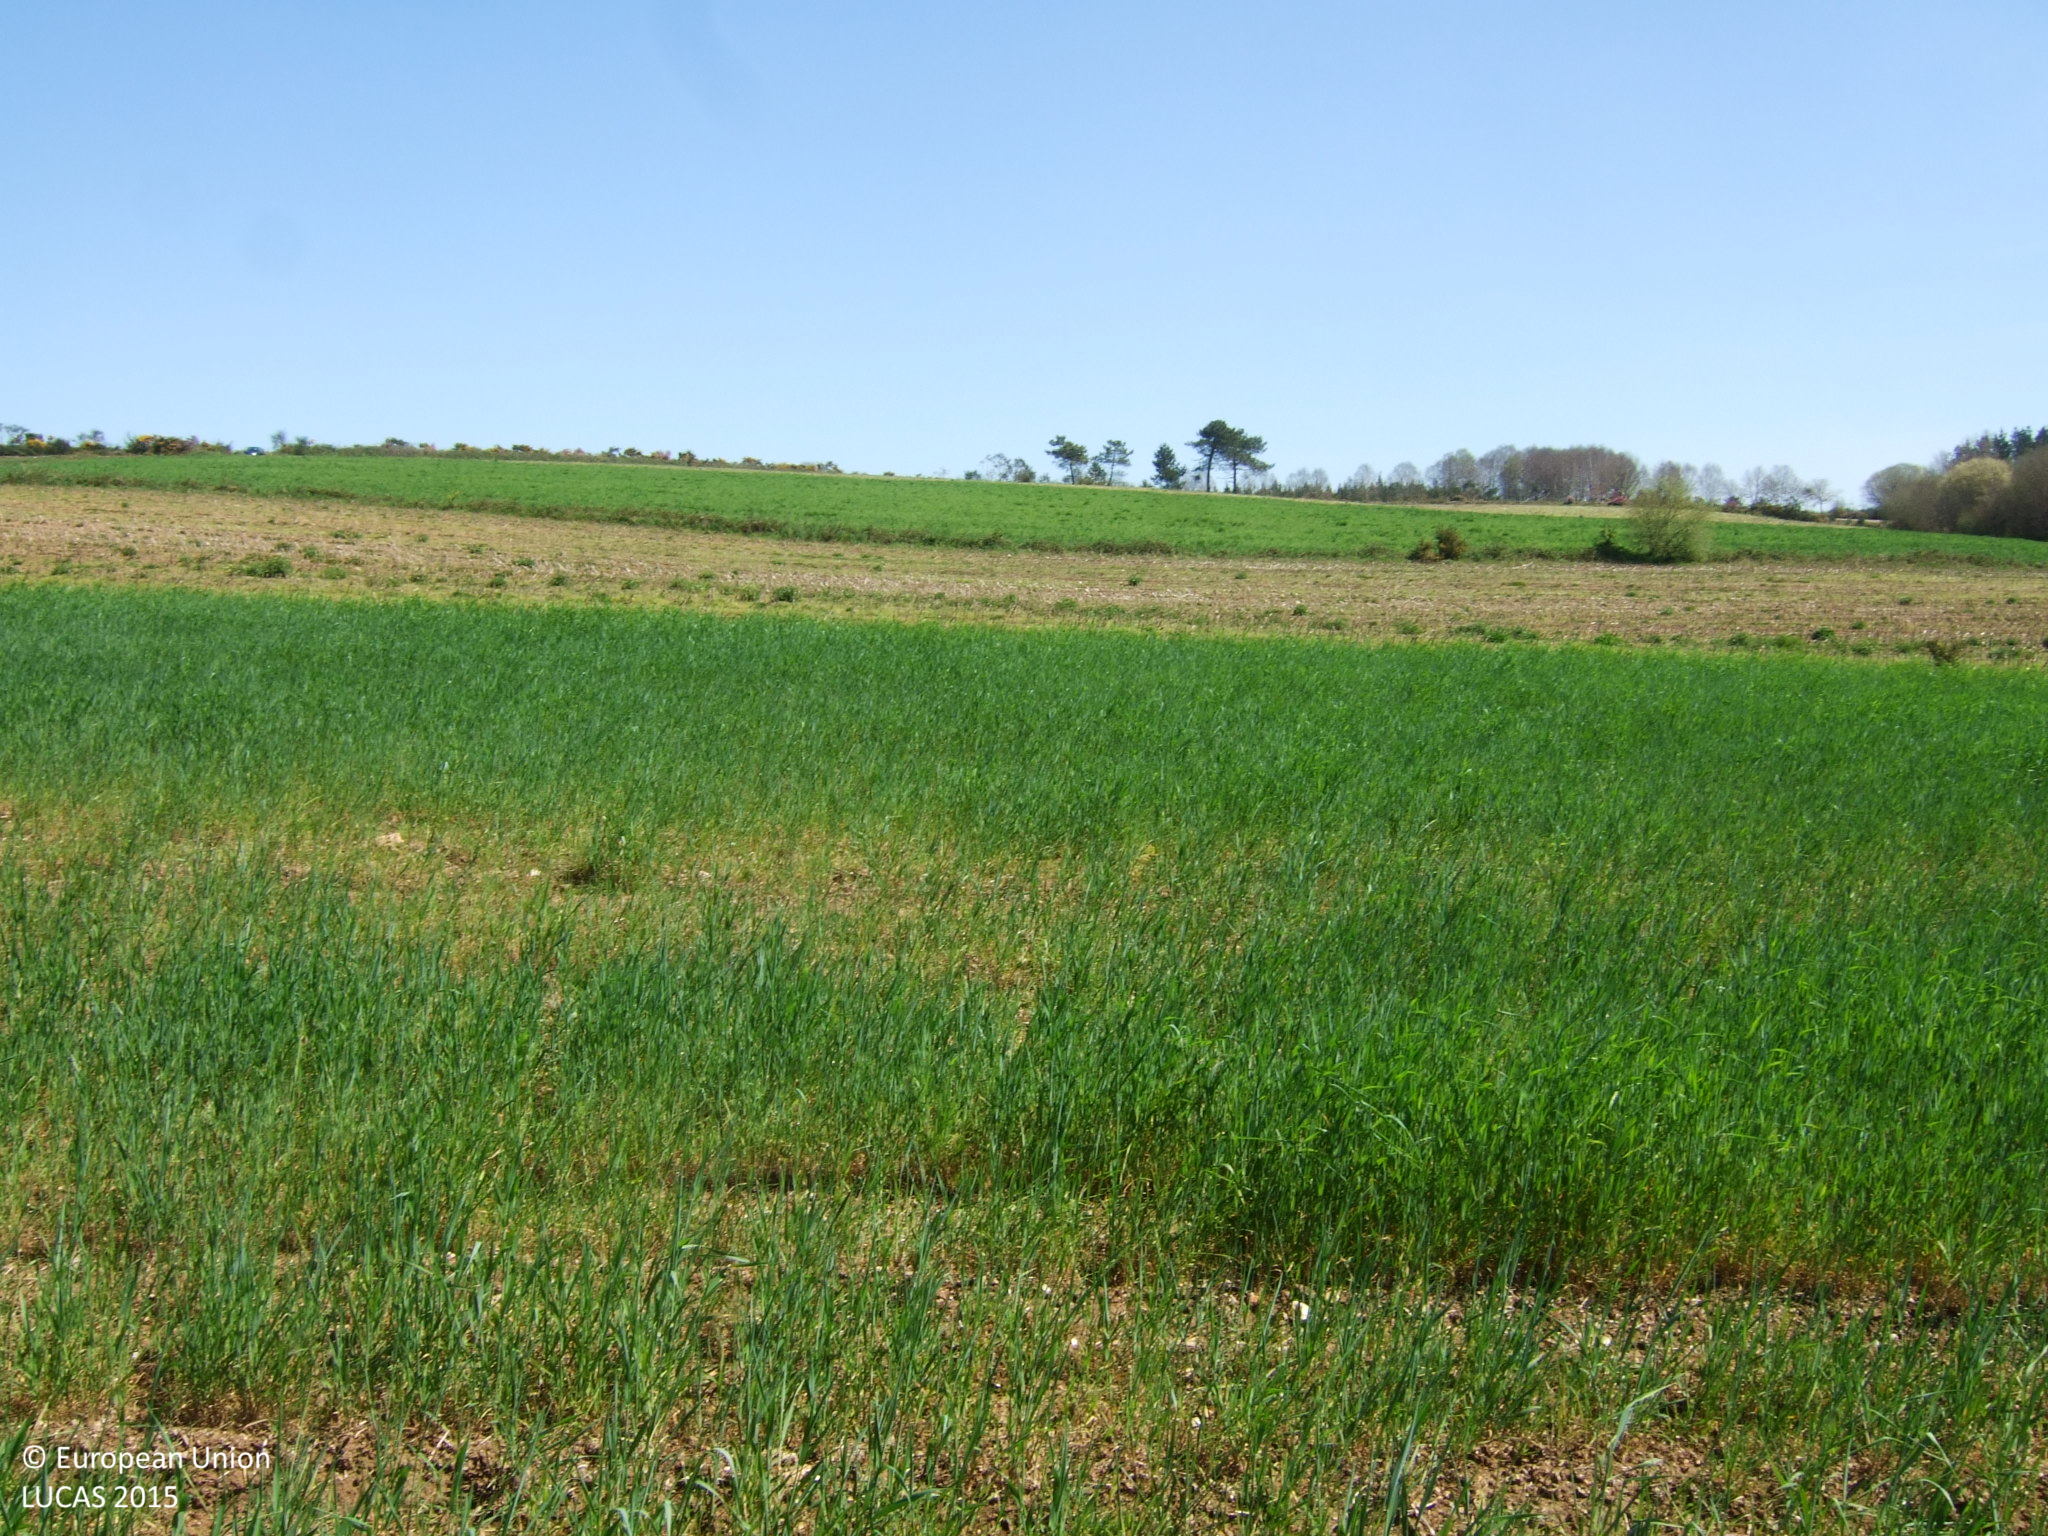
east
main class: Cropland
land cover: Durum wheat
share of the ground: > 75 %
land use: Agriculture (excluding fallow land and kitchen gardens)
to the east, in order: Durum wheat; Other bare soil; Temporary grasslands; Shruby margins; Temporary grasslands
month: April
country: ES
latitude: 42.7835
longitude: -7.7683
